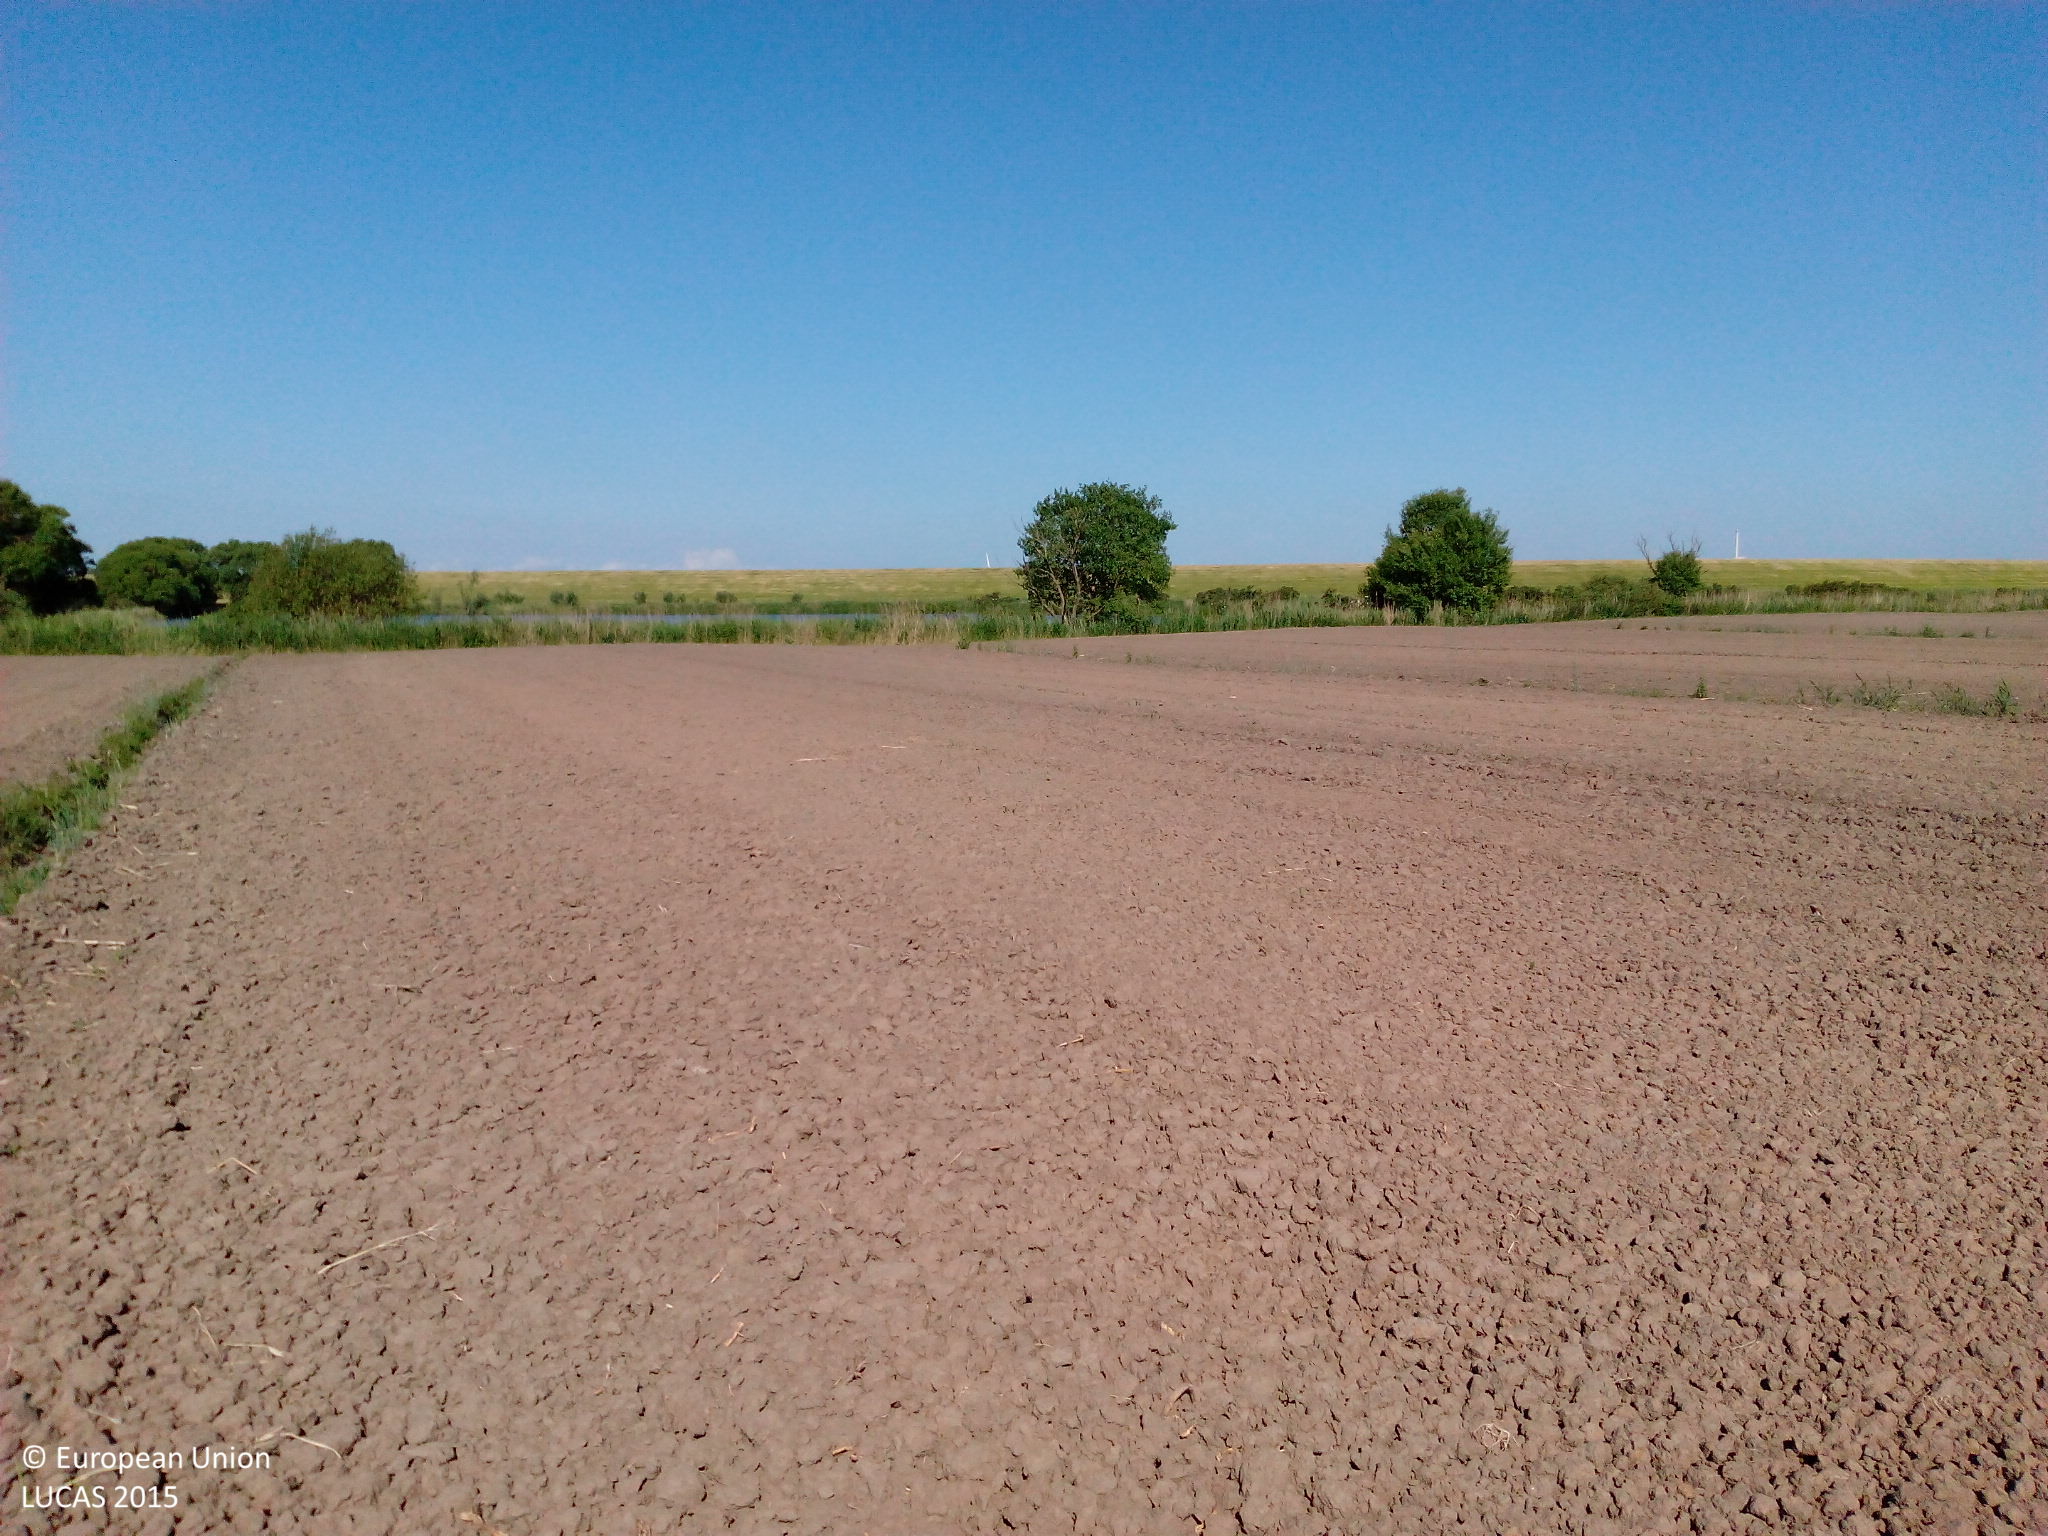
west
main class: Cropland
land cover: Maize
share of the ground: < 10 %
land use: Agriculture (excluding fallow land and kitchen gardens)
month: June
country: DE
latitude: 53.4108
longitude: 8.5113
